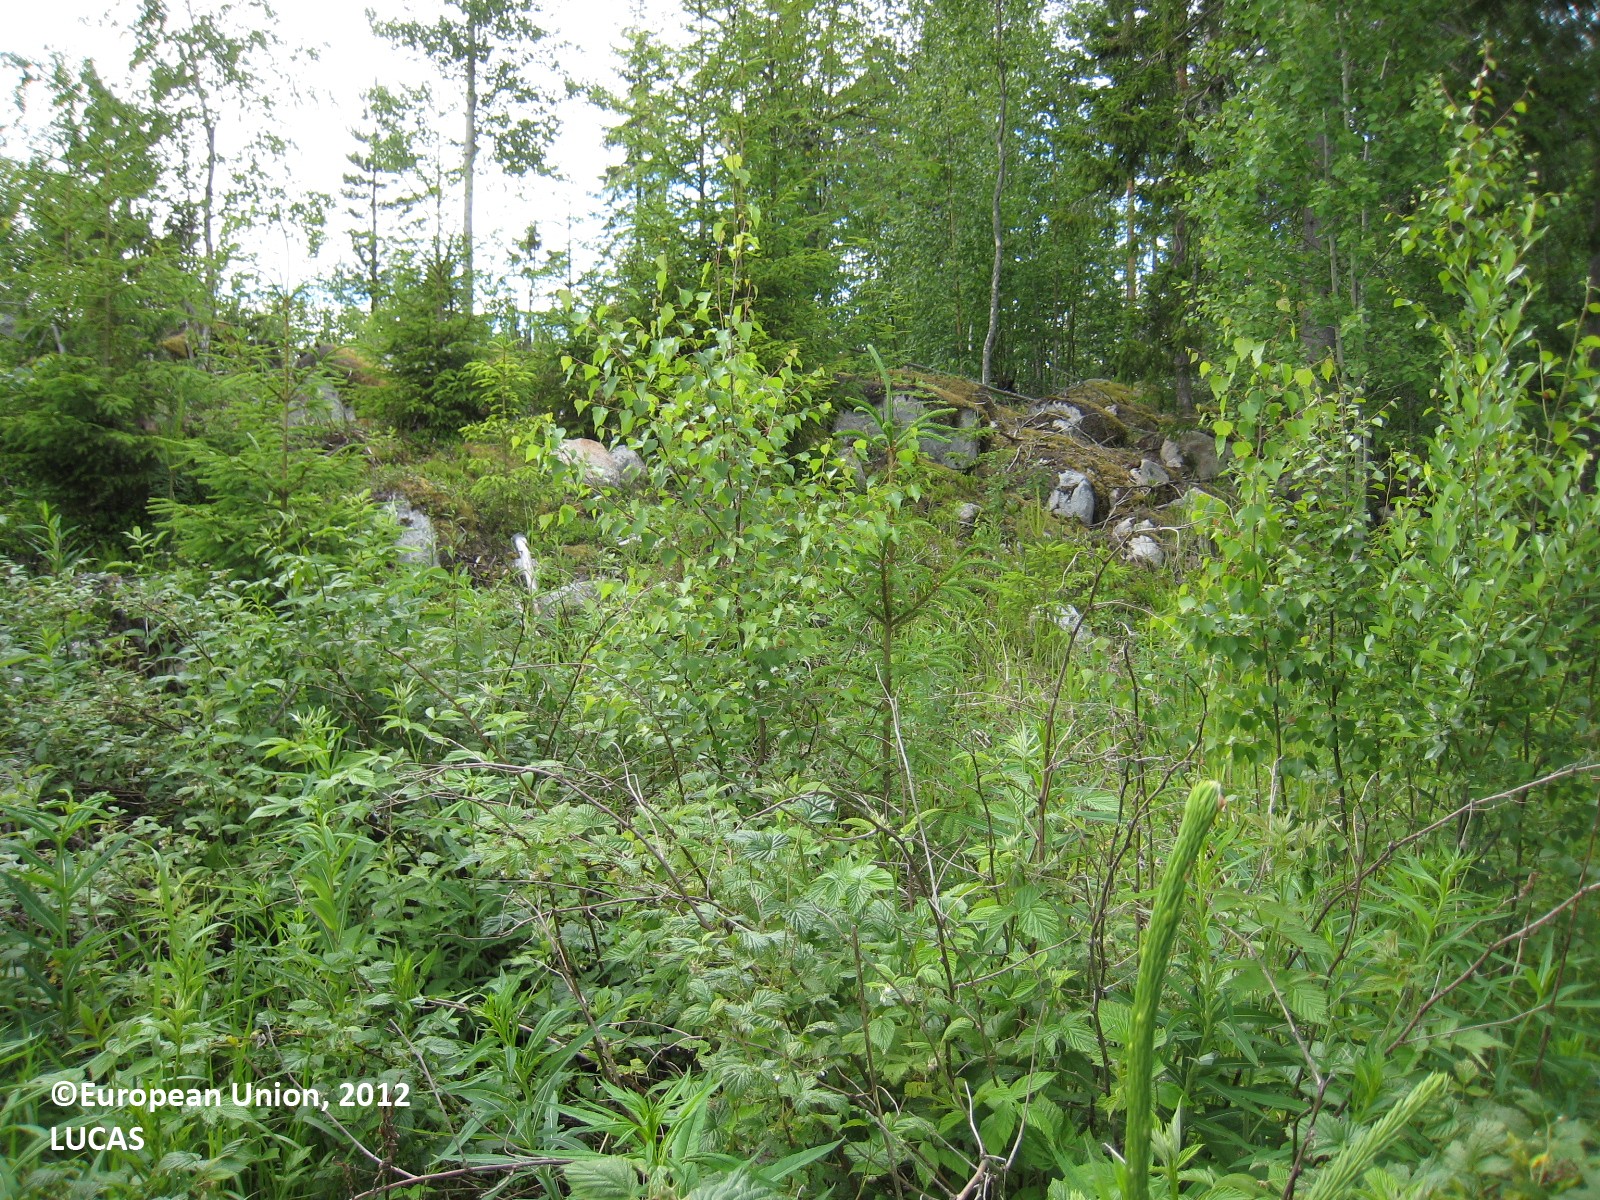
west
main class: Woodland
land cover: Spruce dominated mixed woodland
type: boreal forest
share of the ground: 50 - 75 %
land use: Forestry
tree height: > 5 m
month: June
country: FI
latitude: 61.9745
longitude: 25.7868
